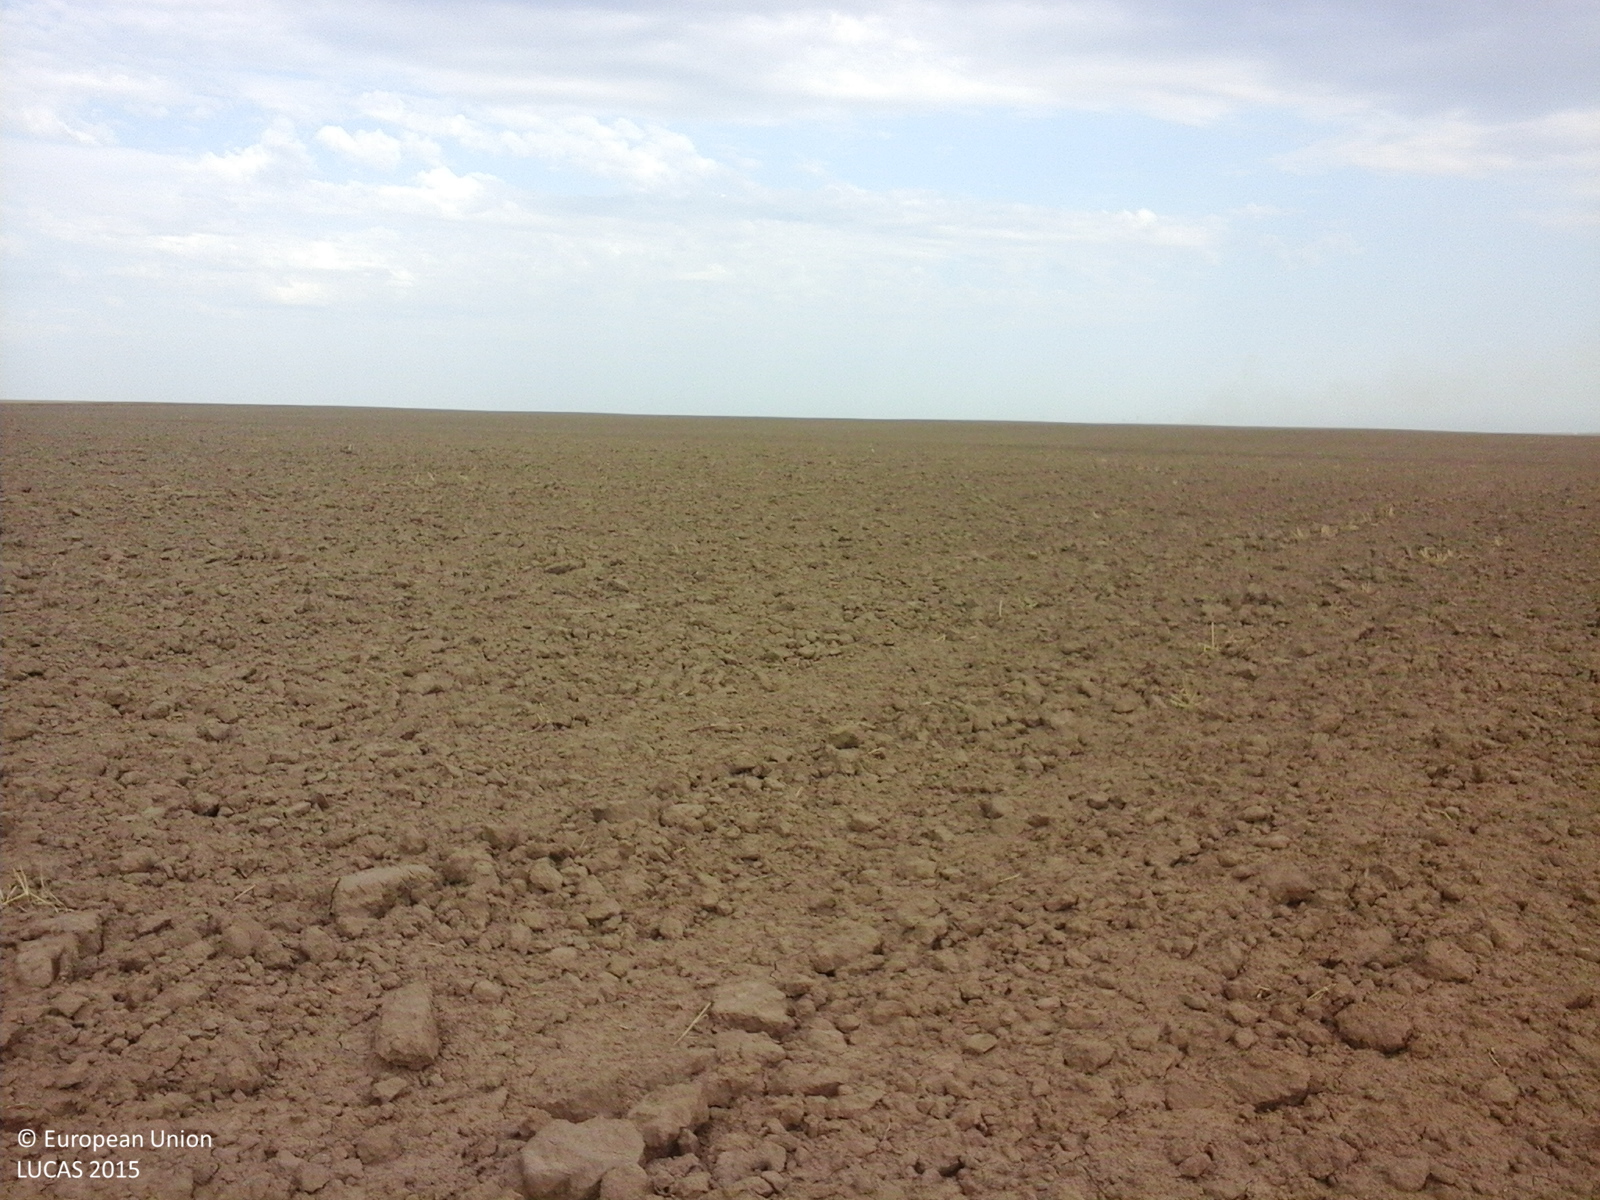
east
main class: Cropland
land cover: Common wheat
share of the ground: < 10 %
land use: Agriculture (excluding fallow land and kitchen gardens)
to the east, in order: Common wheat
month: August
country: RO
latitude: 44.3545
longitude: 28.1645
